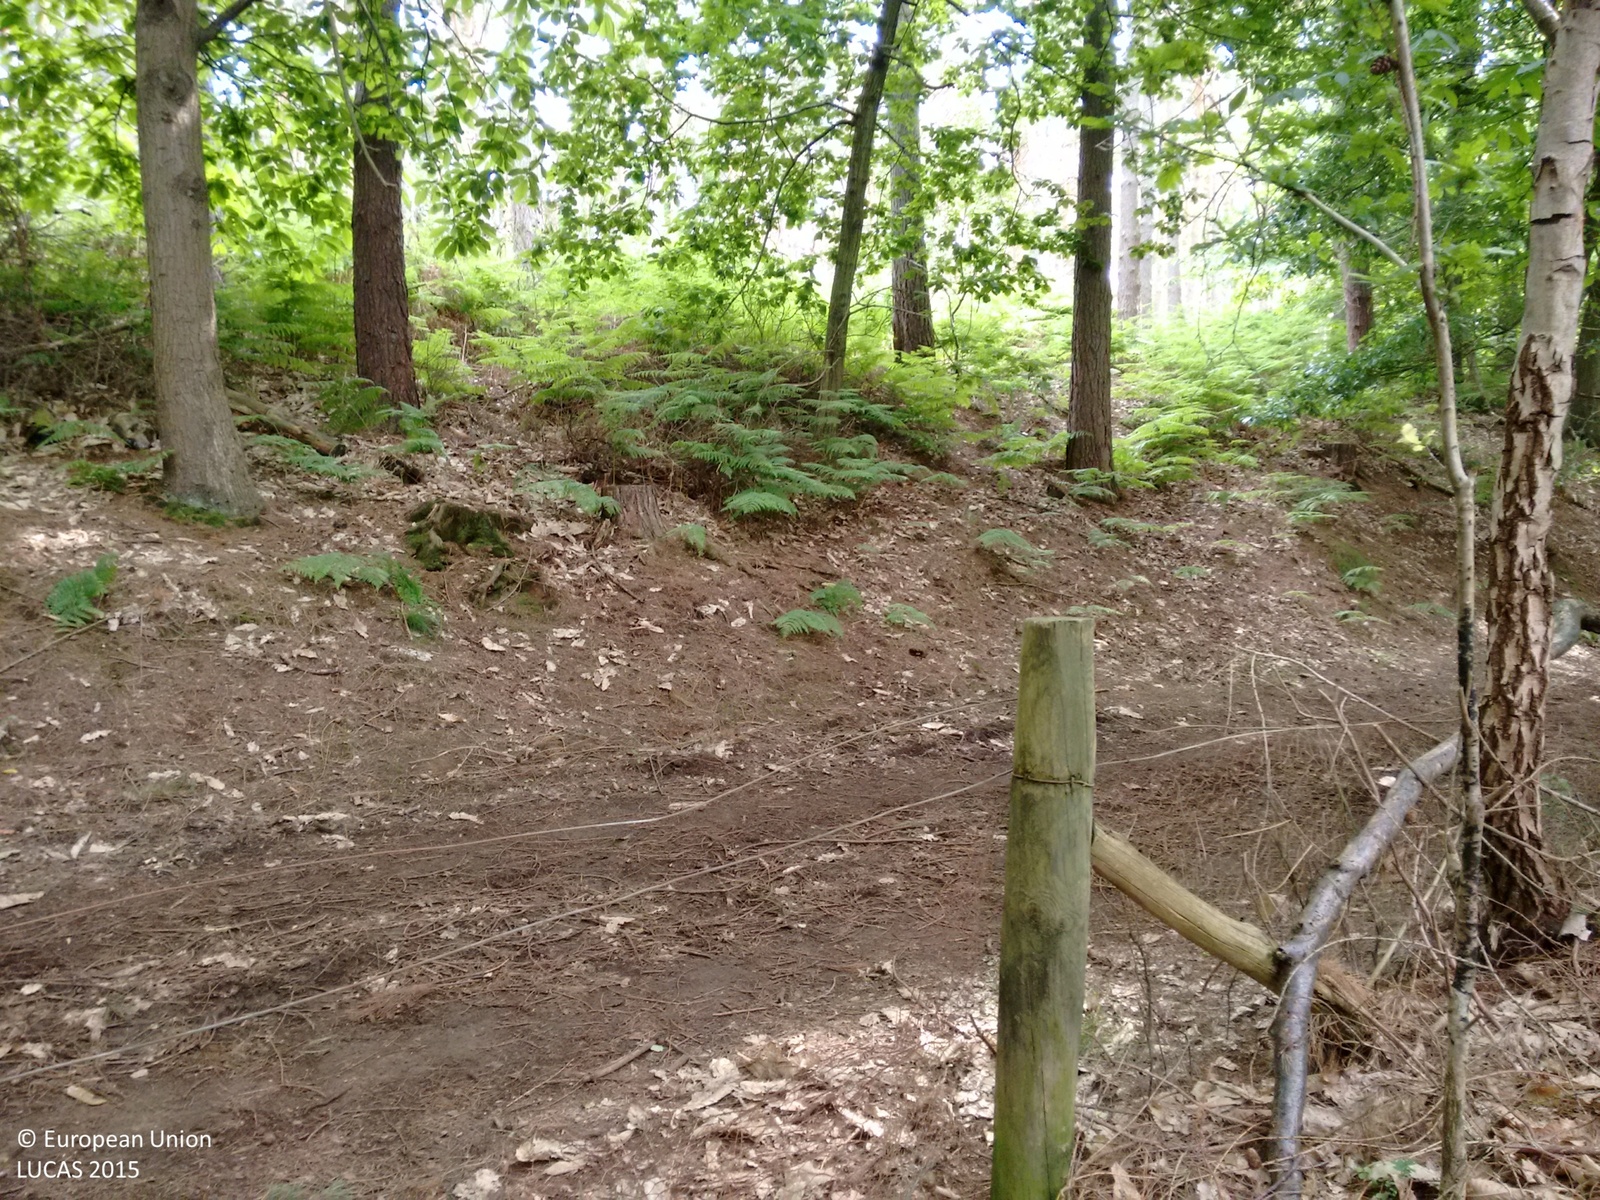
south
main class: Woodland
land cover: Pine dominated coniferous woodland
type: exotic forest
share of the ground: > 75 %
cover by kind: coniferous forest trees 90 %, broadleaved forest trees 10 %
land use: Forestry
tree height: > 5 m
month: June
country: GB
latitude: 52.0049
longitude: -0.6598
